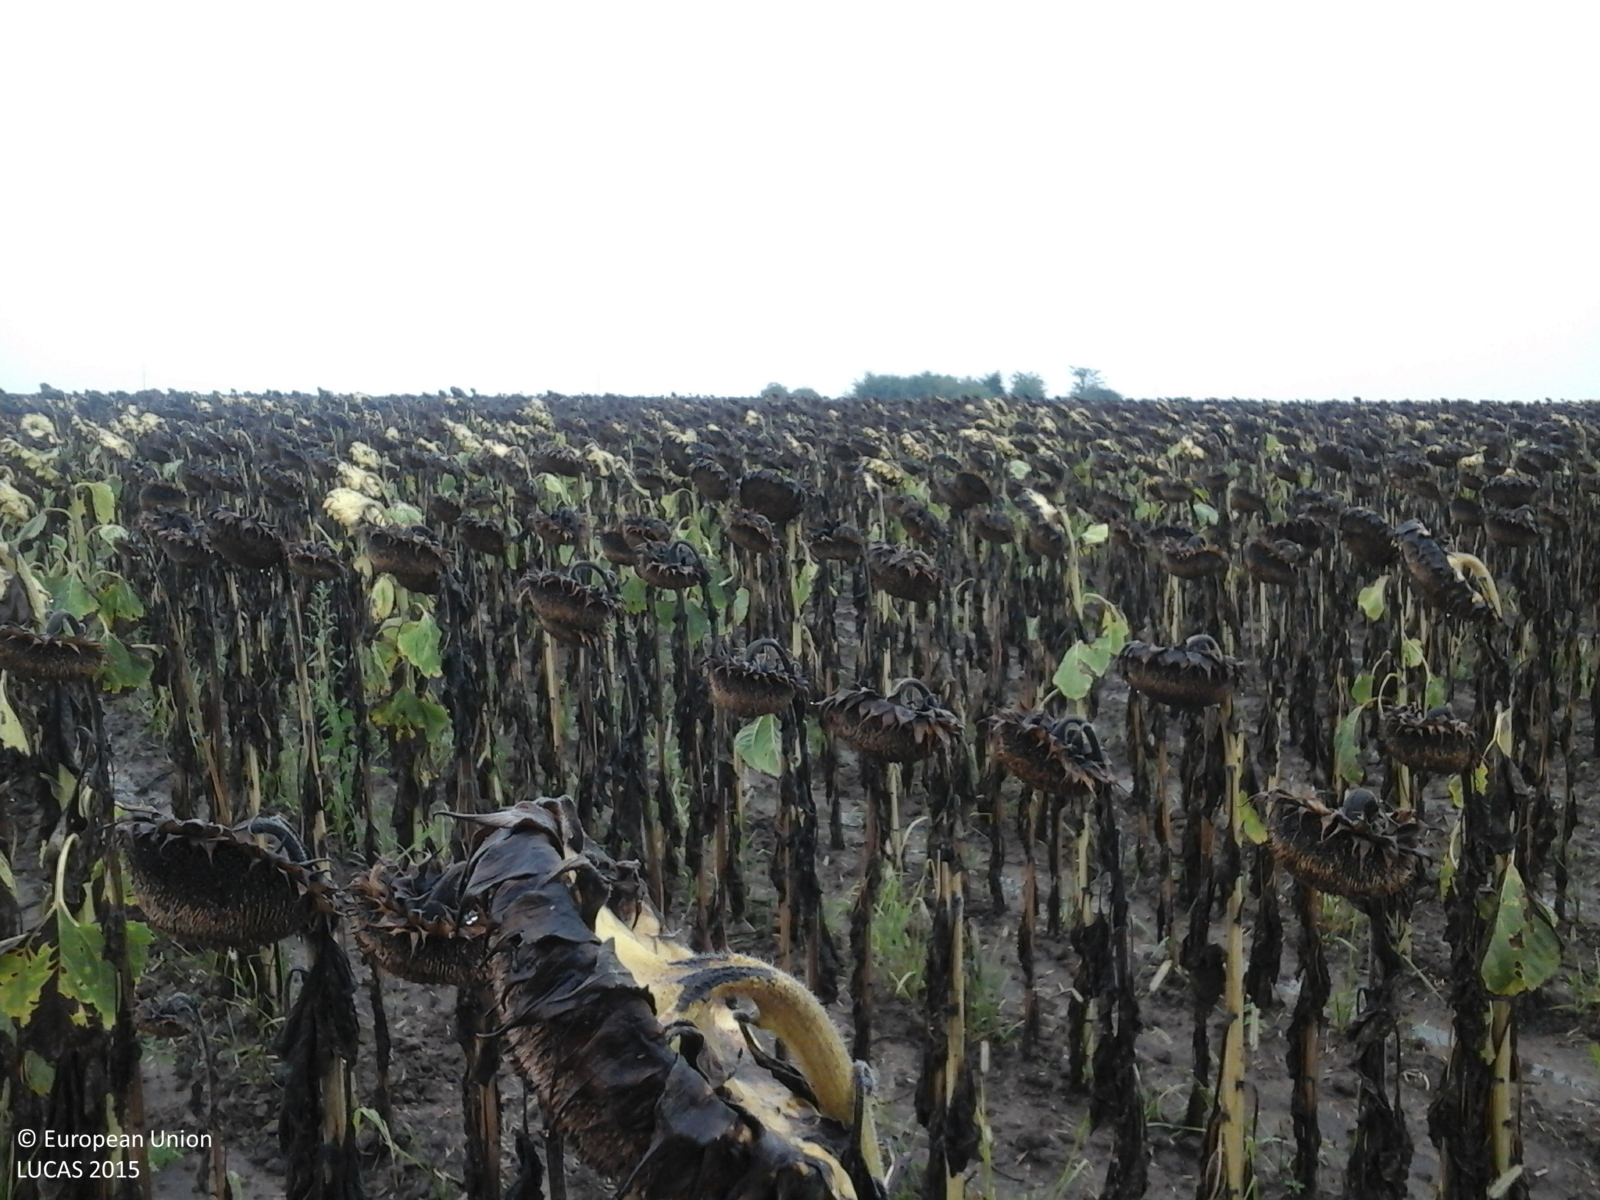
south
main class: Cropland
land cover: Sunflower
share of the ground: > 75 %
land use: Agriculture (excluding fallow land and kitchen gardens)
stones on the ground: 10 - 25 %
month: August
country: RO
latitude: 45.6620
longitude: 21.1048
